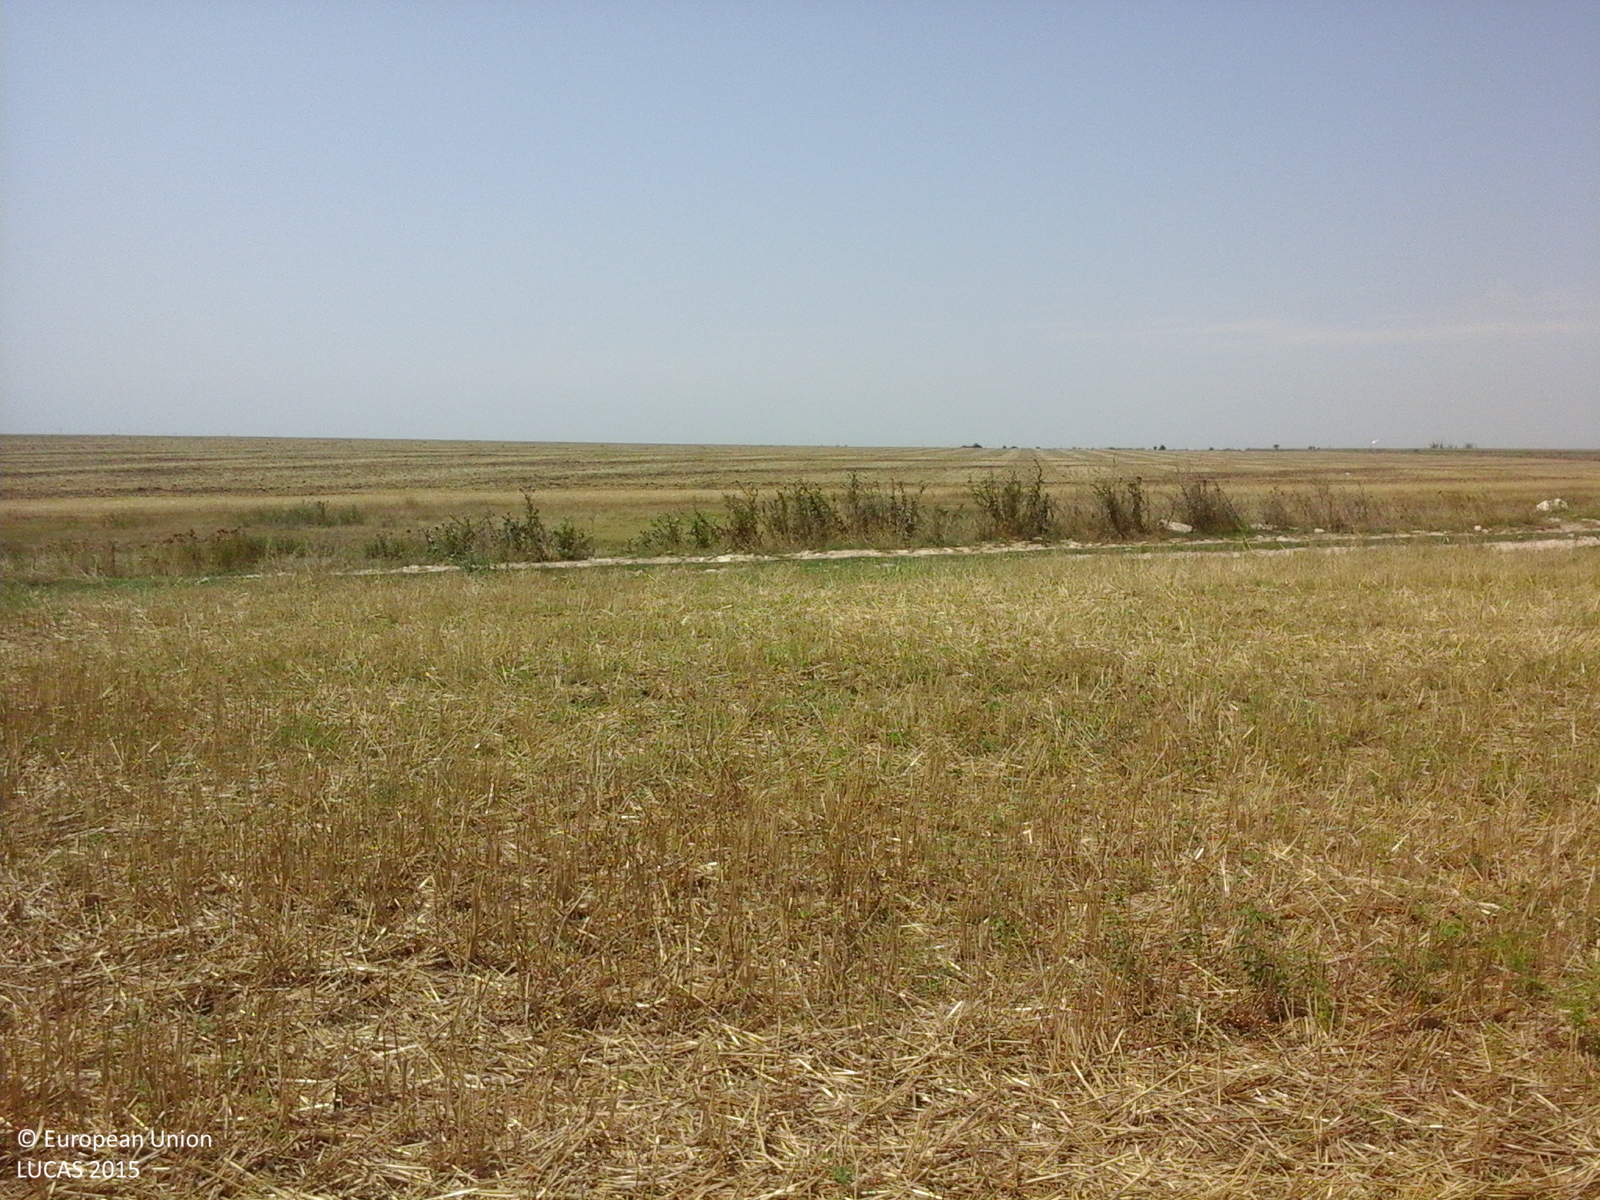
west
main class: Cropland
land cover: Common wheat
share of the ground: > 75 %
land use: Agriculture (excluding fallow land and kitchen gardens)
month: August
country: RO
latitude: 44.0797
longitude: 28.4616
